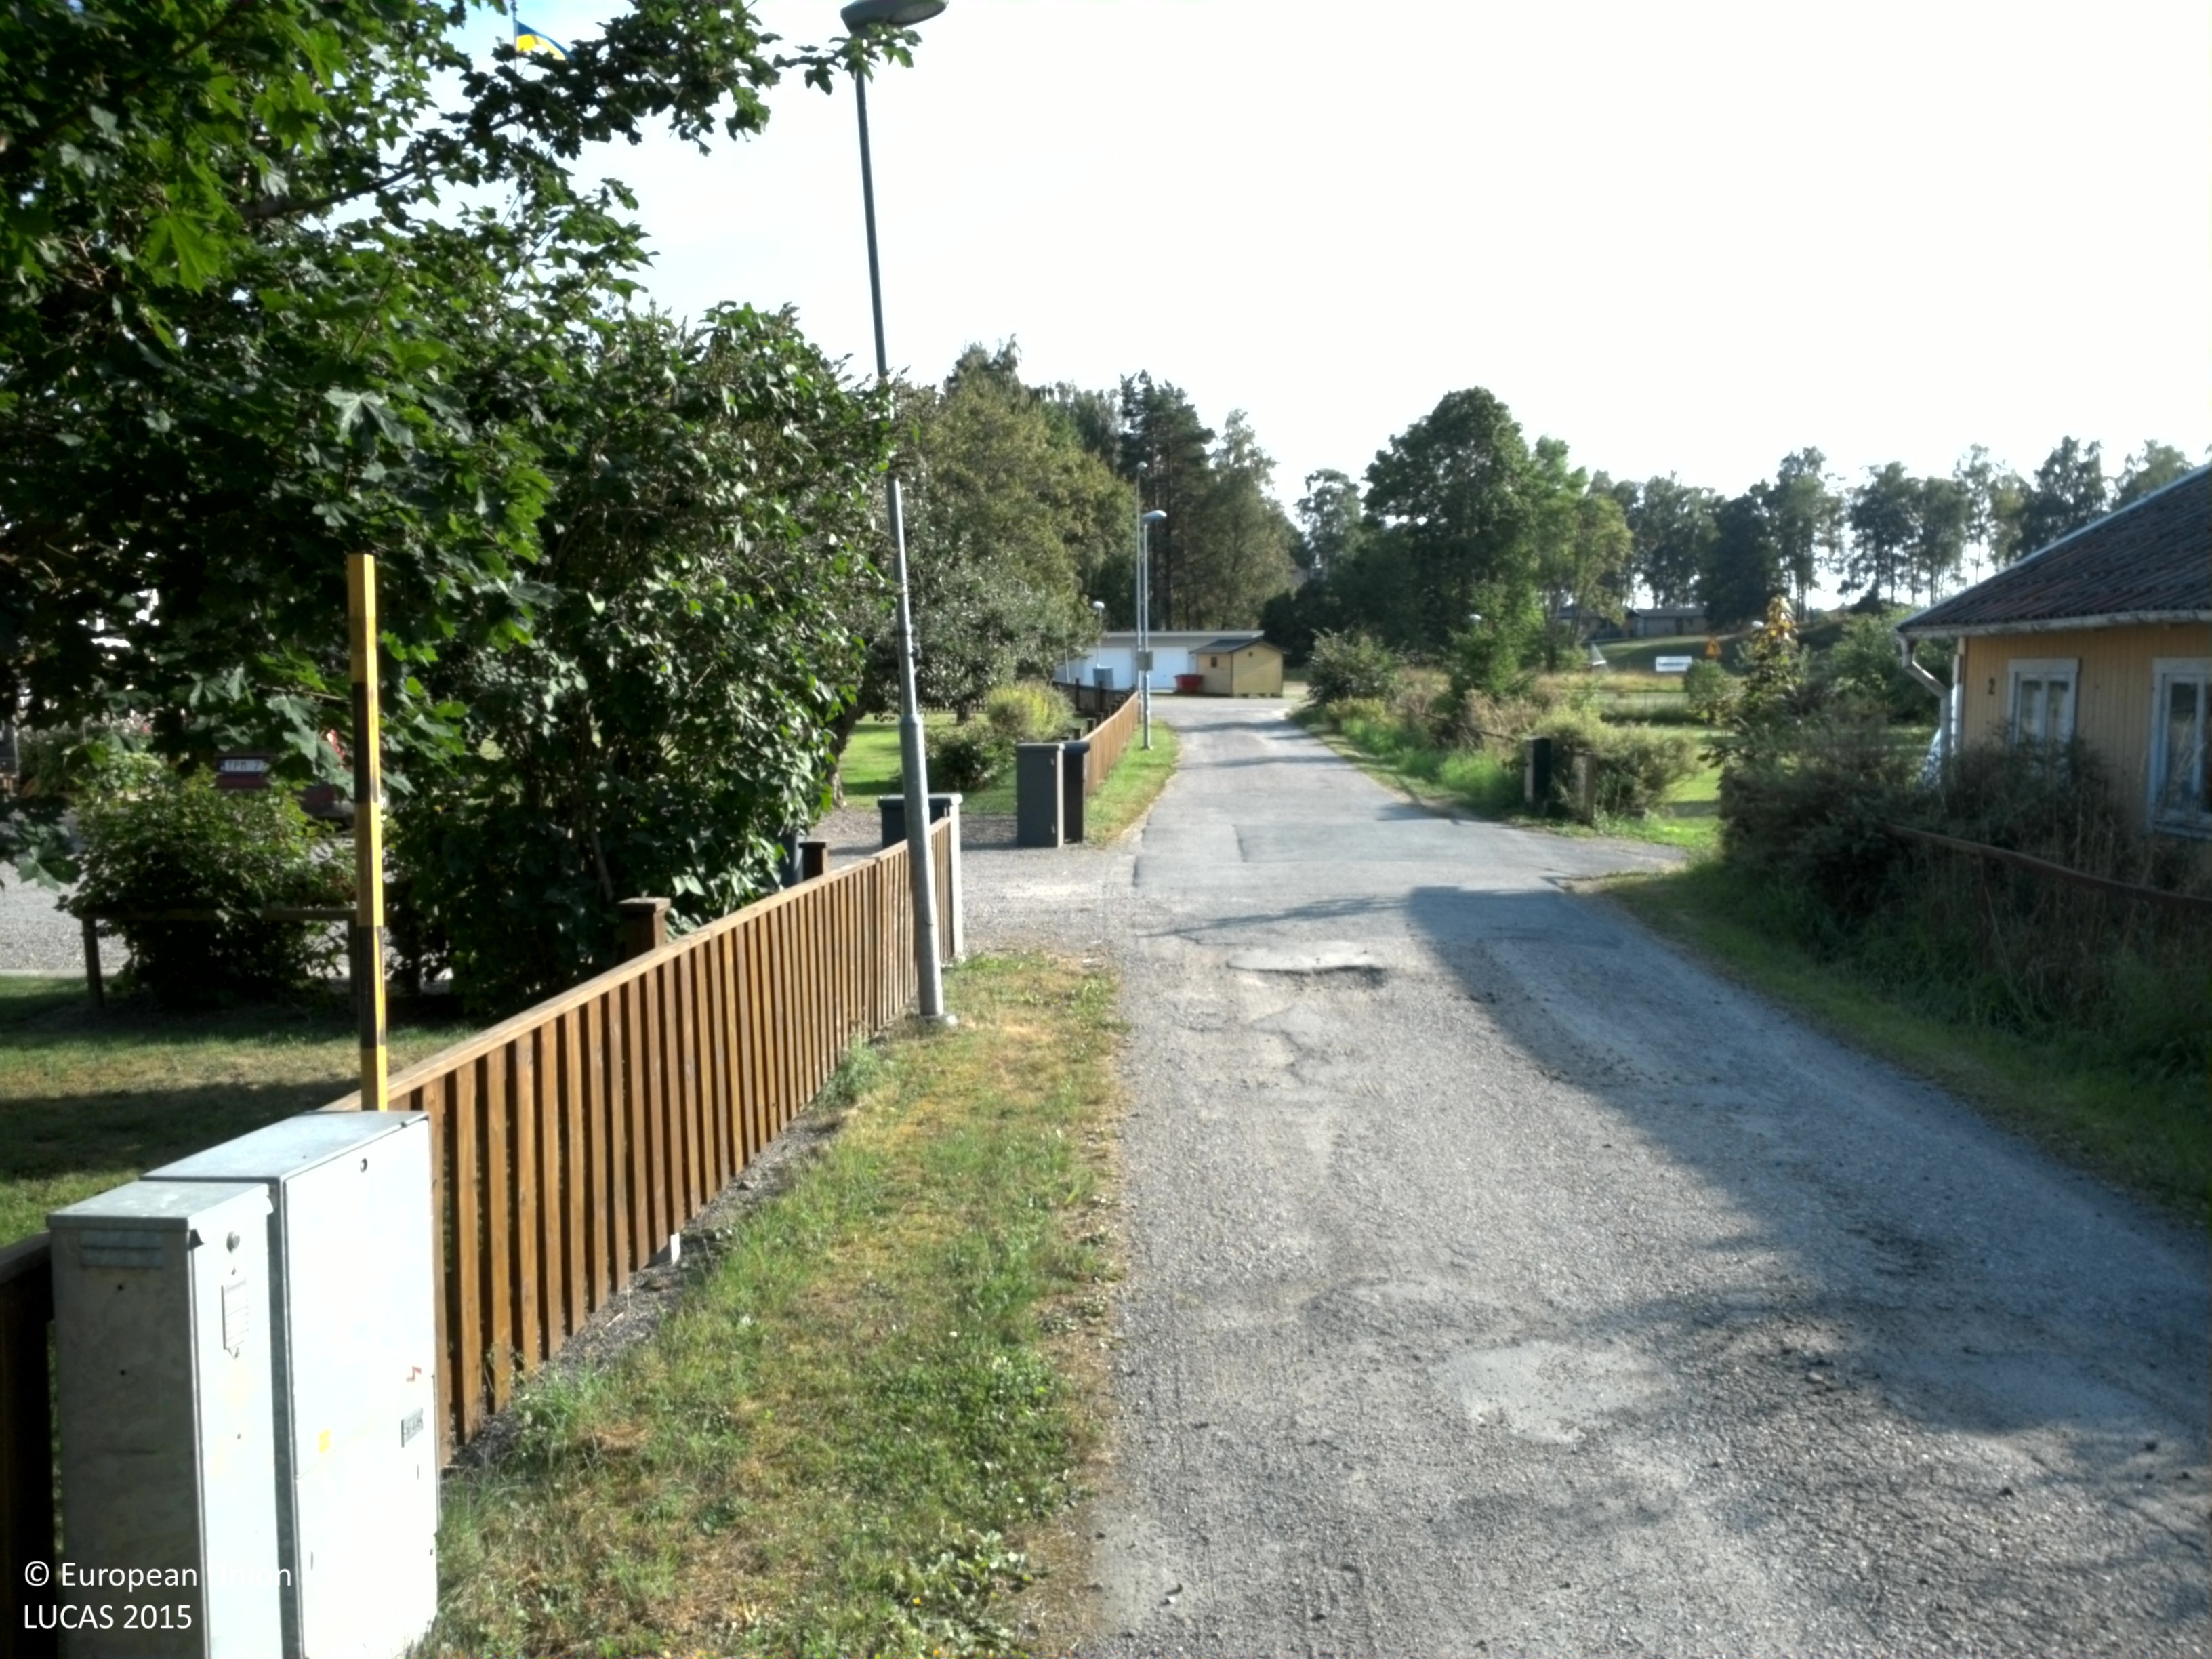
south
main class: Grassland
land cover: Grassland with sparse tree/shrub cover
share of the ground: > 75 %
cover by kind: herbaceous plants 95 %, broadleaved forest trees 5 %
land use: Residential
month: August
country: SE
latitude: 60.0230
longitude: 17.7272
